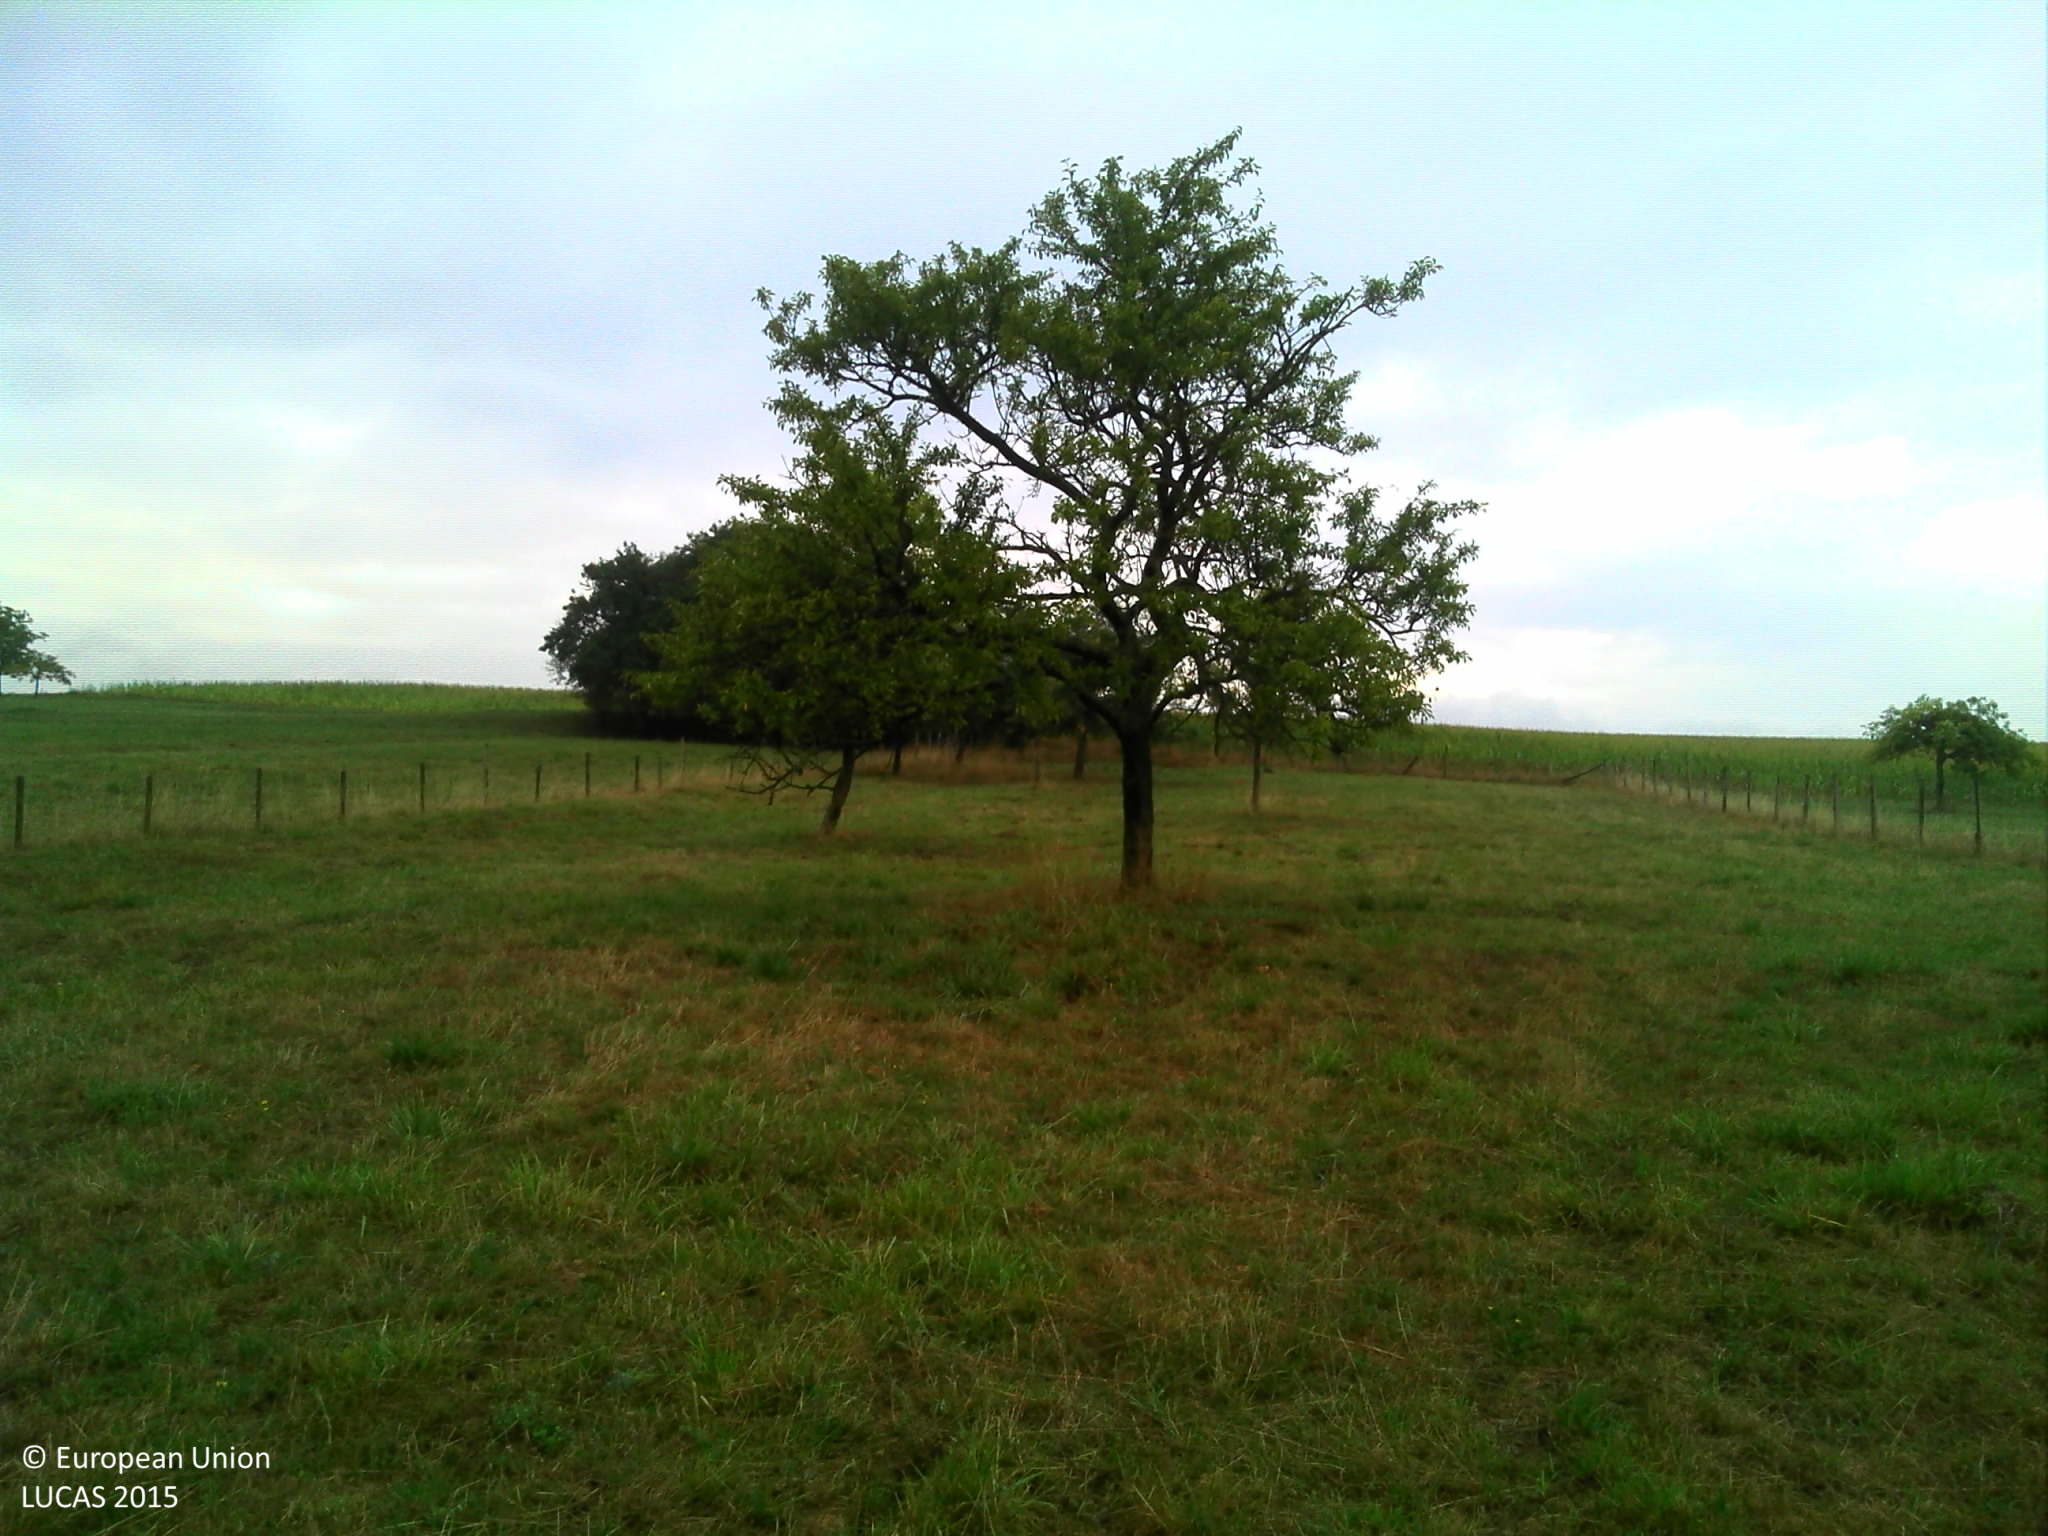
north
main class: Grassland
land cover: Grassland with sparse tree/shrub cover
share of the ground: > 75 %
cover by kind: herbaceous plants 95 %, broadleaved forest trees 5 %
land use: Agriculture (excluding fallow land and kitchen gardens)
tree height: > 5 m
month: August
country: FR
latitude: 48.8800
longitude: 7.5325
